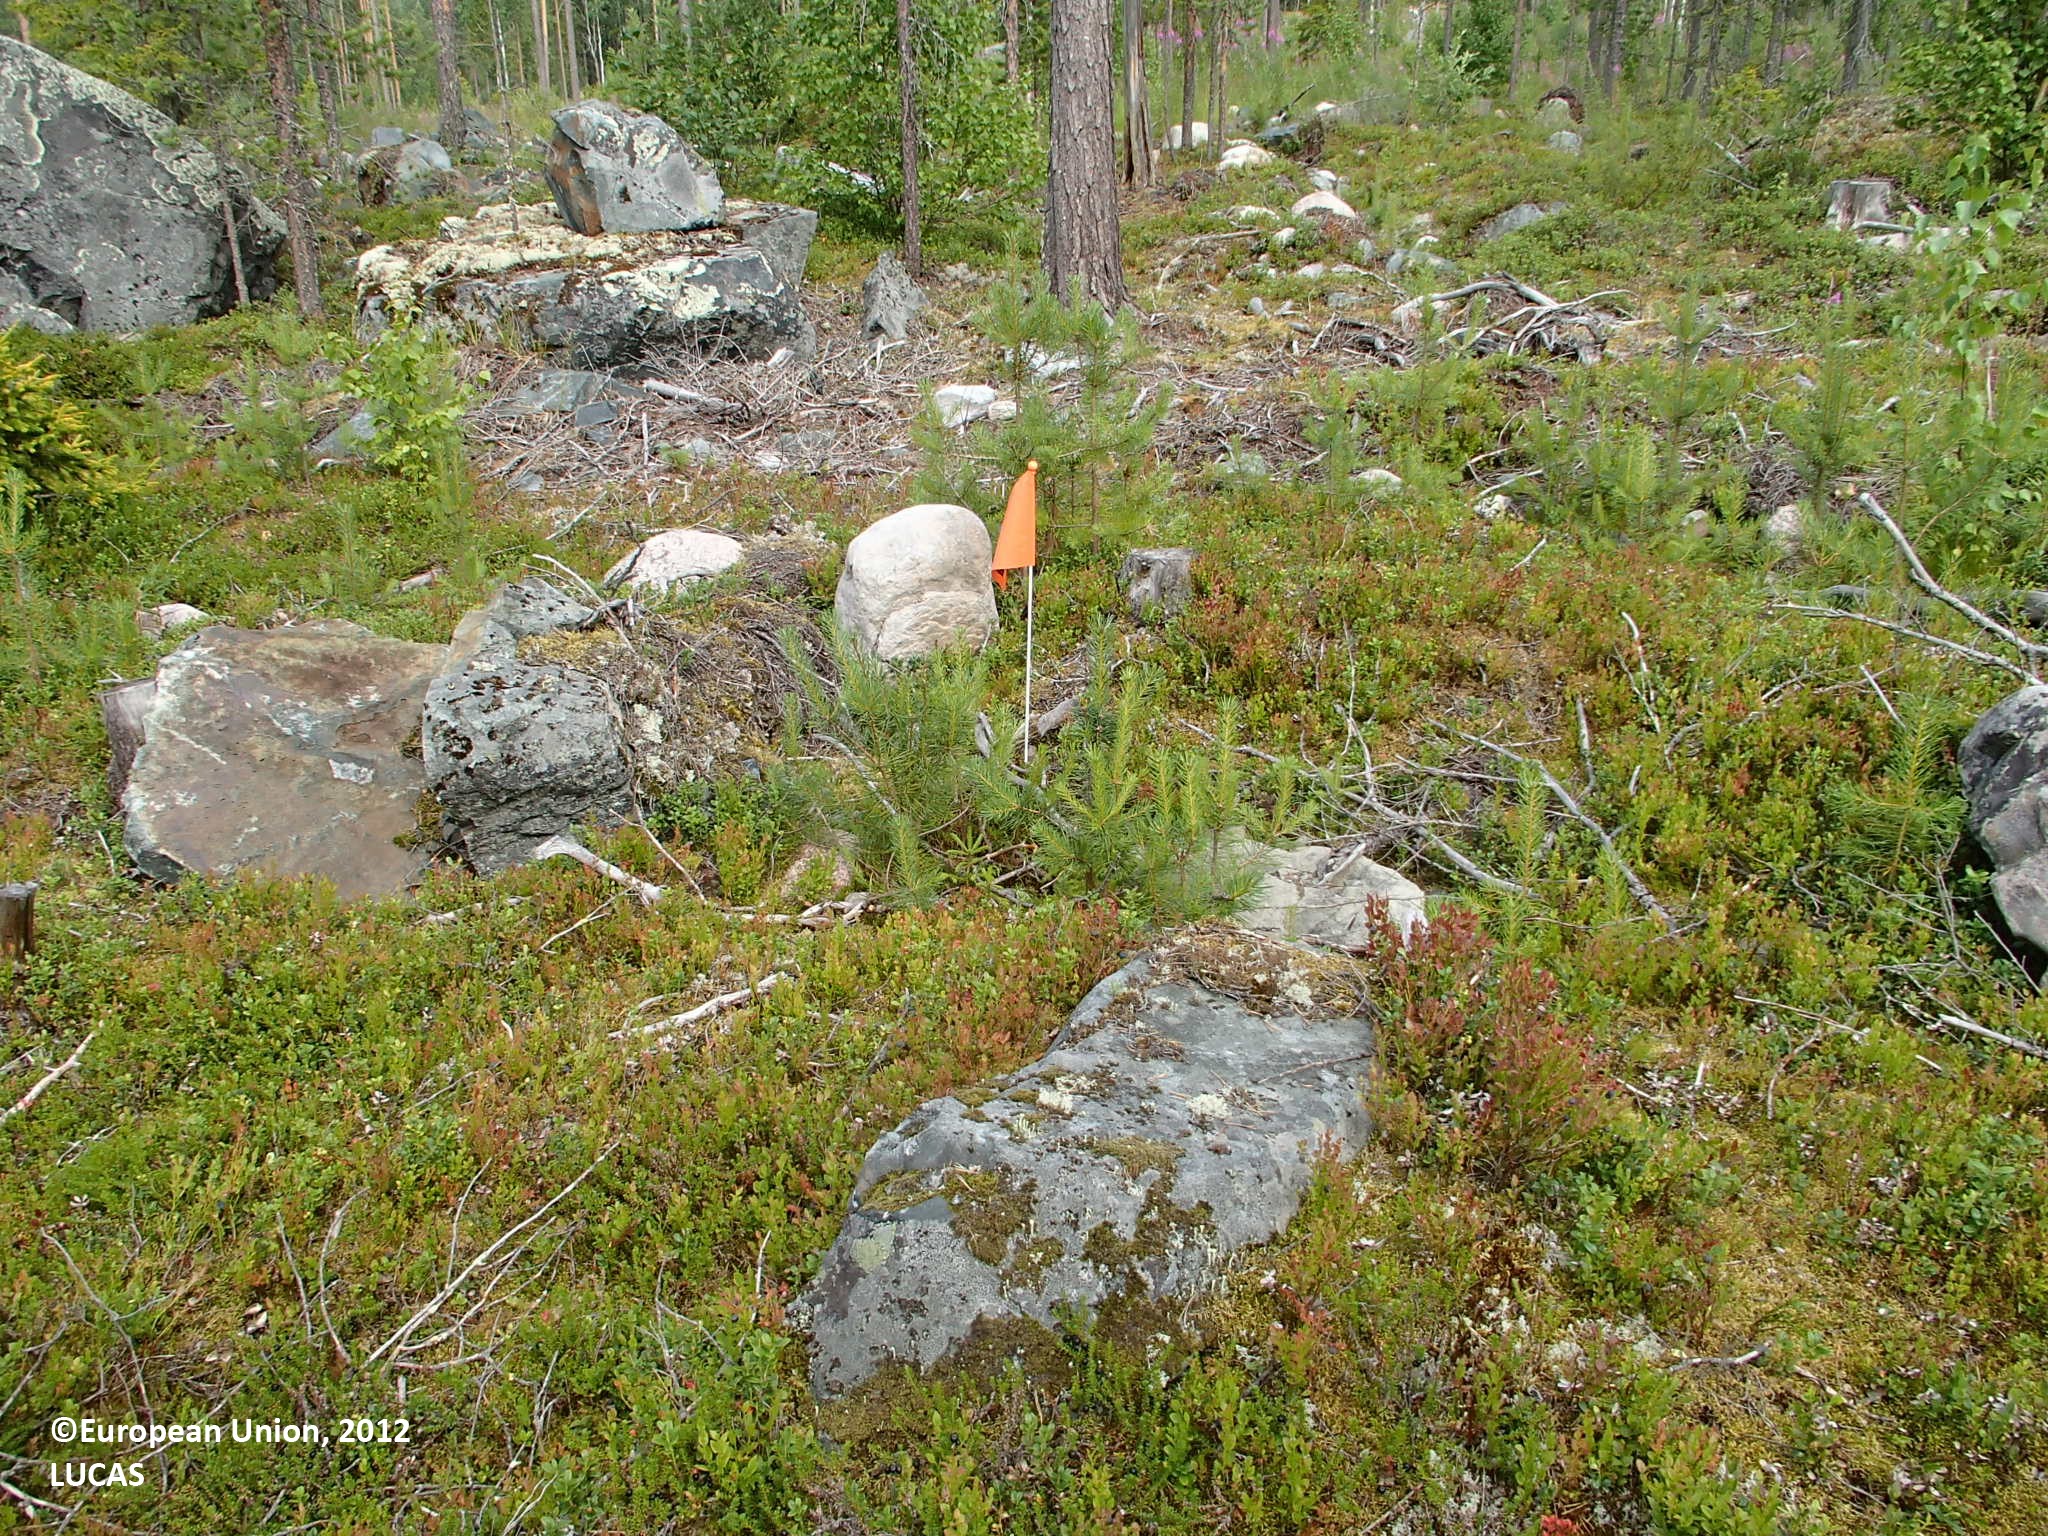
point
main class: Woodland
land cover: Pine dominated coniferous woodland
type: boreal forest
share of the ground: 10 - 25 %
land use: Forestry
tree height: > 5 m
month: July
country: FI
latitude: 66.1965
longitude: 25.3639
